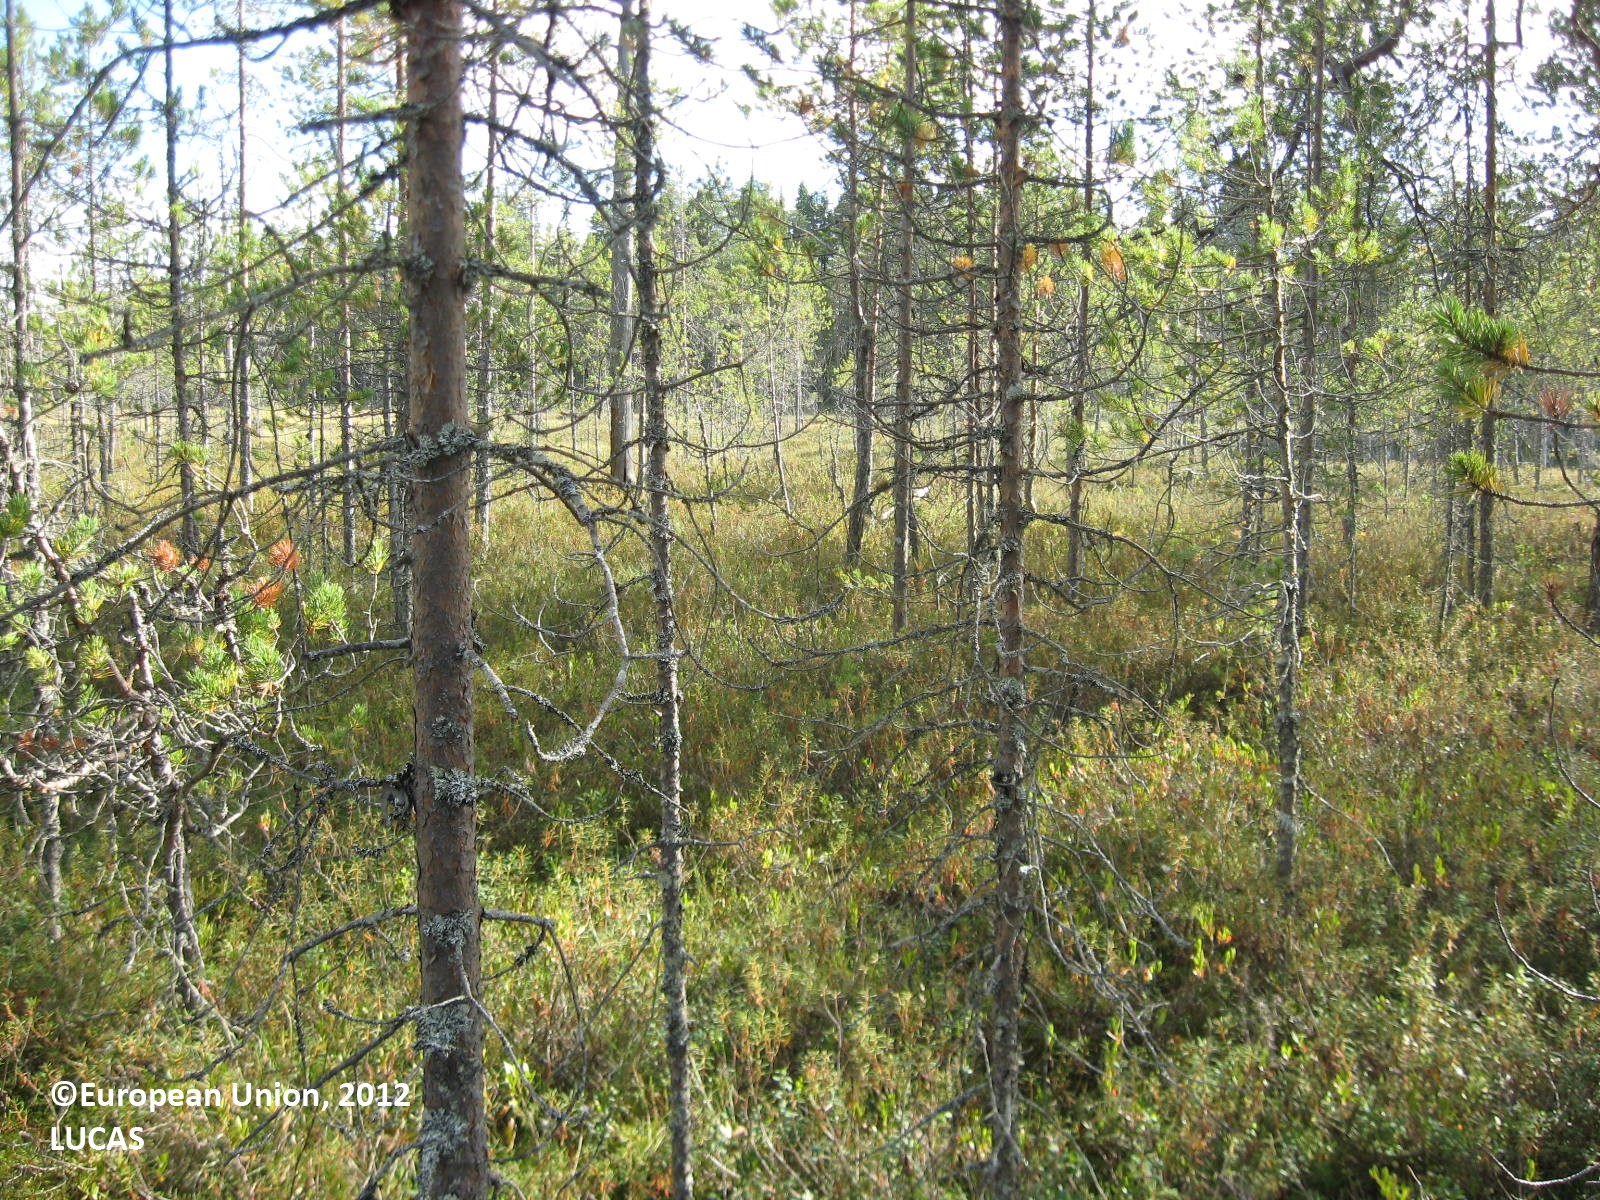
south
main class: Woodland
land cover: Pine dominated coniferous woodland
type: boreal forest
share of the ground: 50 - 75 %
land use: Semi-natural and natural areas not in use
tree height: > 5 m
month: August
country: FI
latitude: 63.8402
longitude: 29.2201
